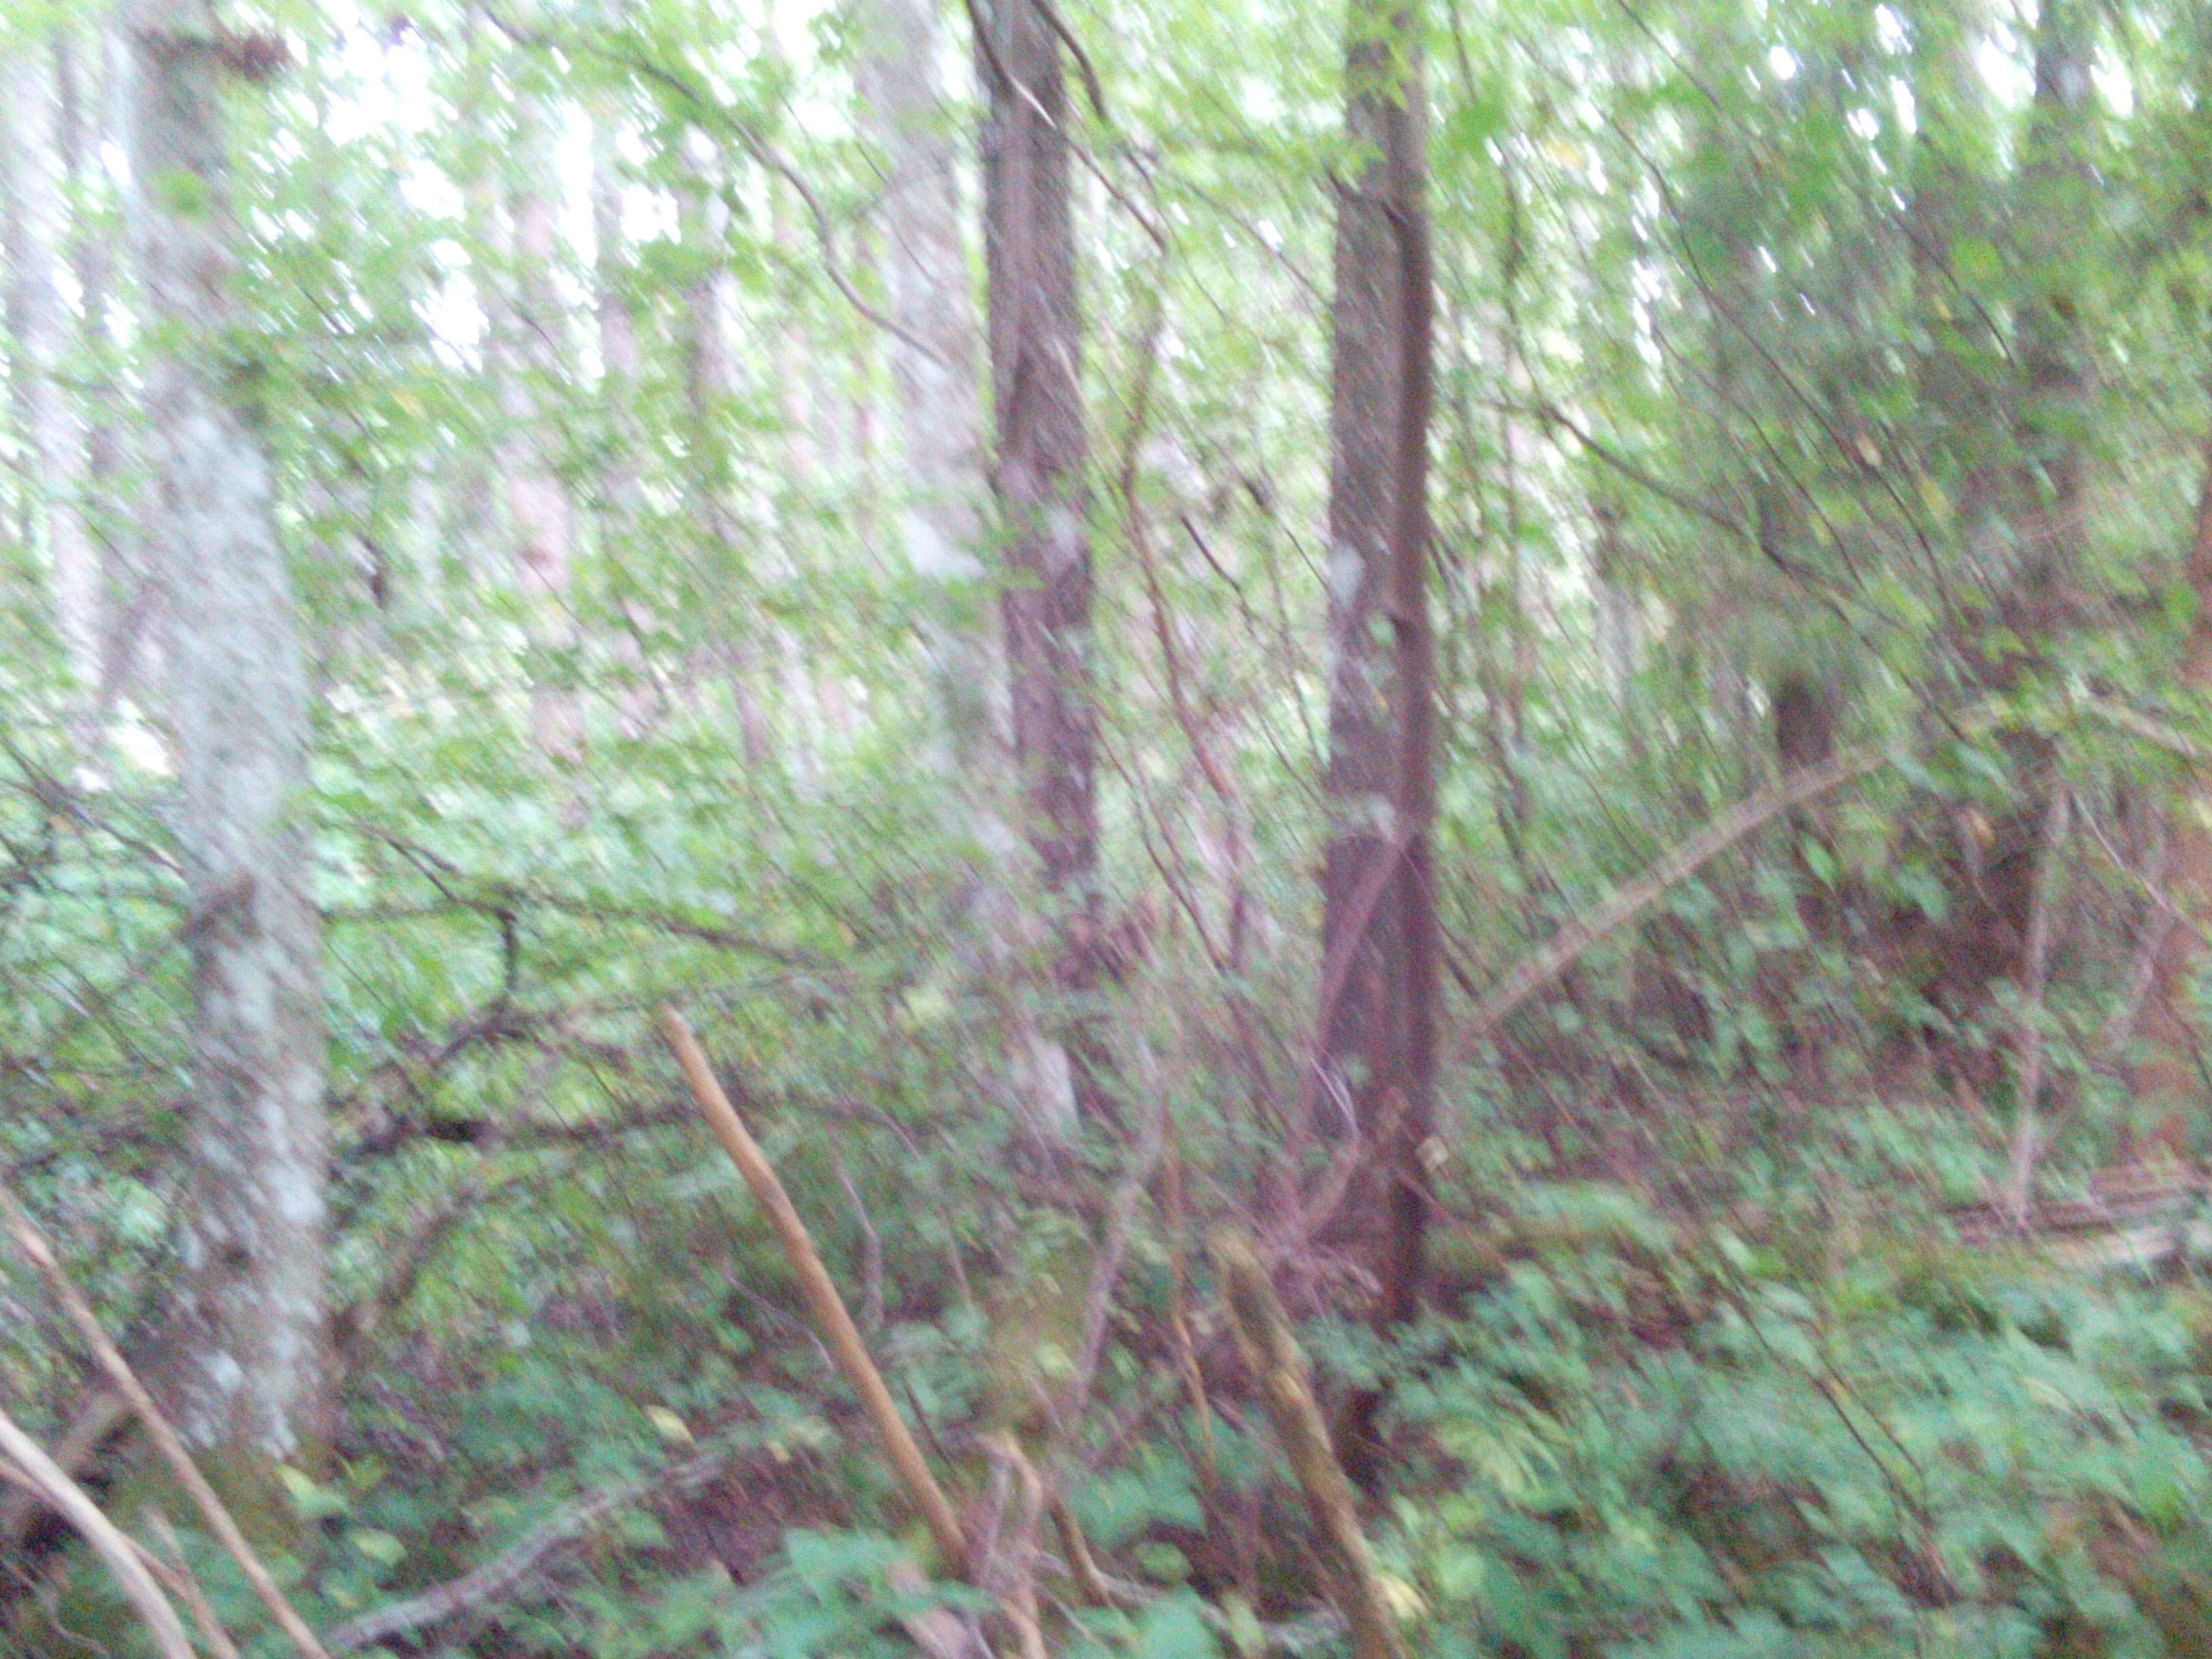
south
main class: Woodland
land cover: Broadleaved woodland
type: non-riverine alder, birch or aspen forest
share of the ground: > 75 %
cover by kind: broadleaved forest trees 80 %, shrubs 10 %, herbaceous plants 10 %
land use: Forestry
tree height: > 5 m
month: July
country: LV
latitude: 56.9828
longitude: 22.2444
